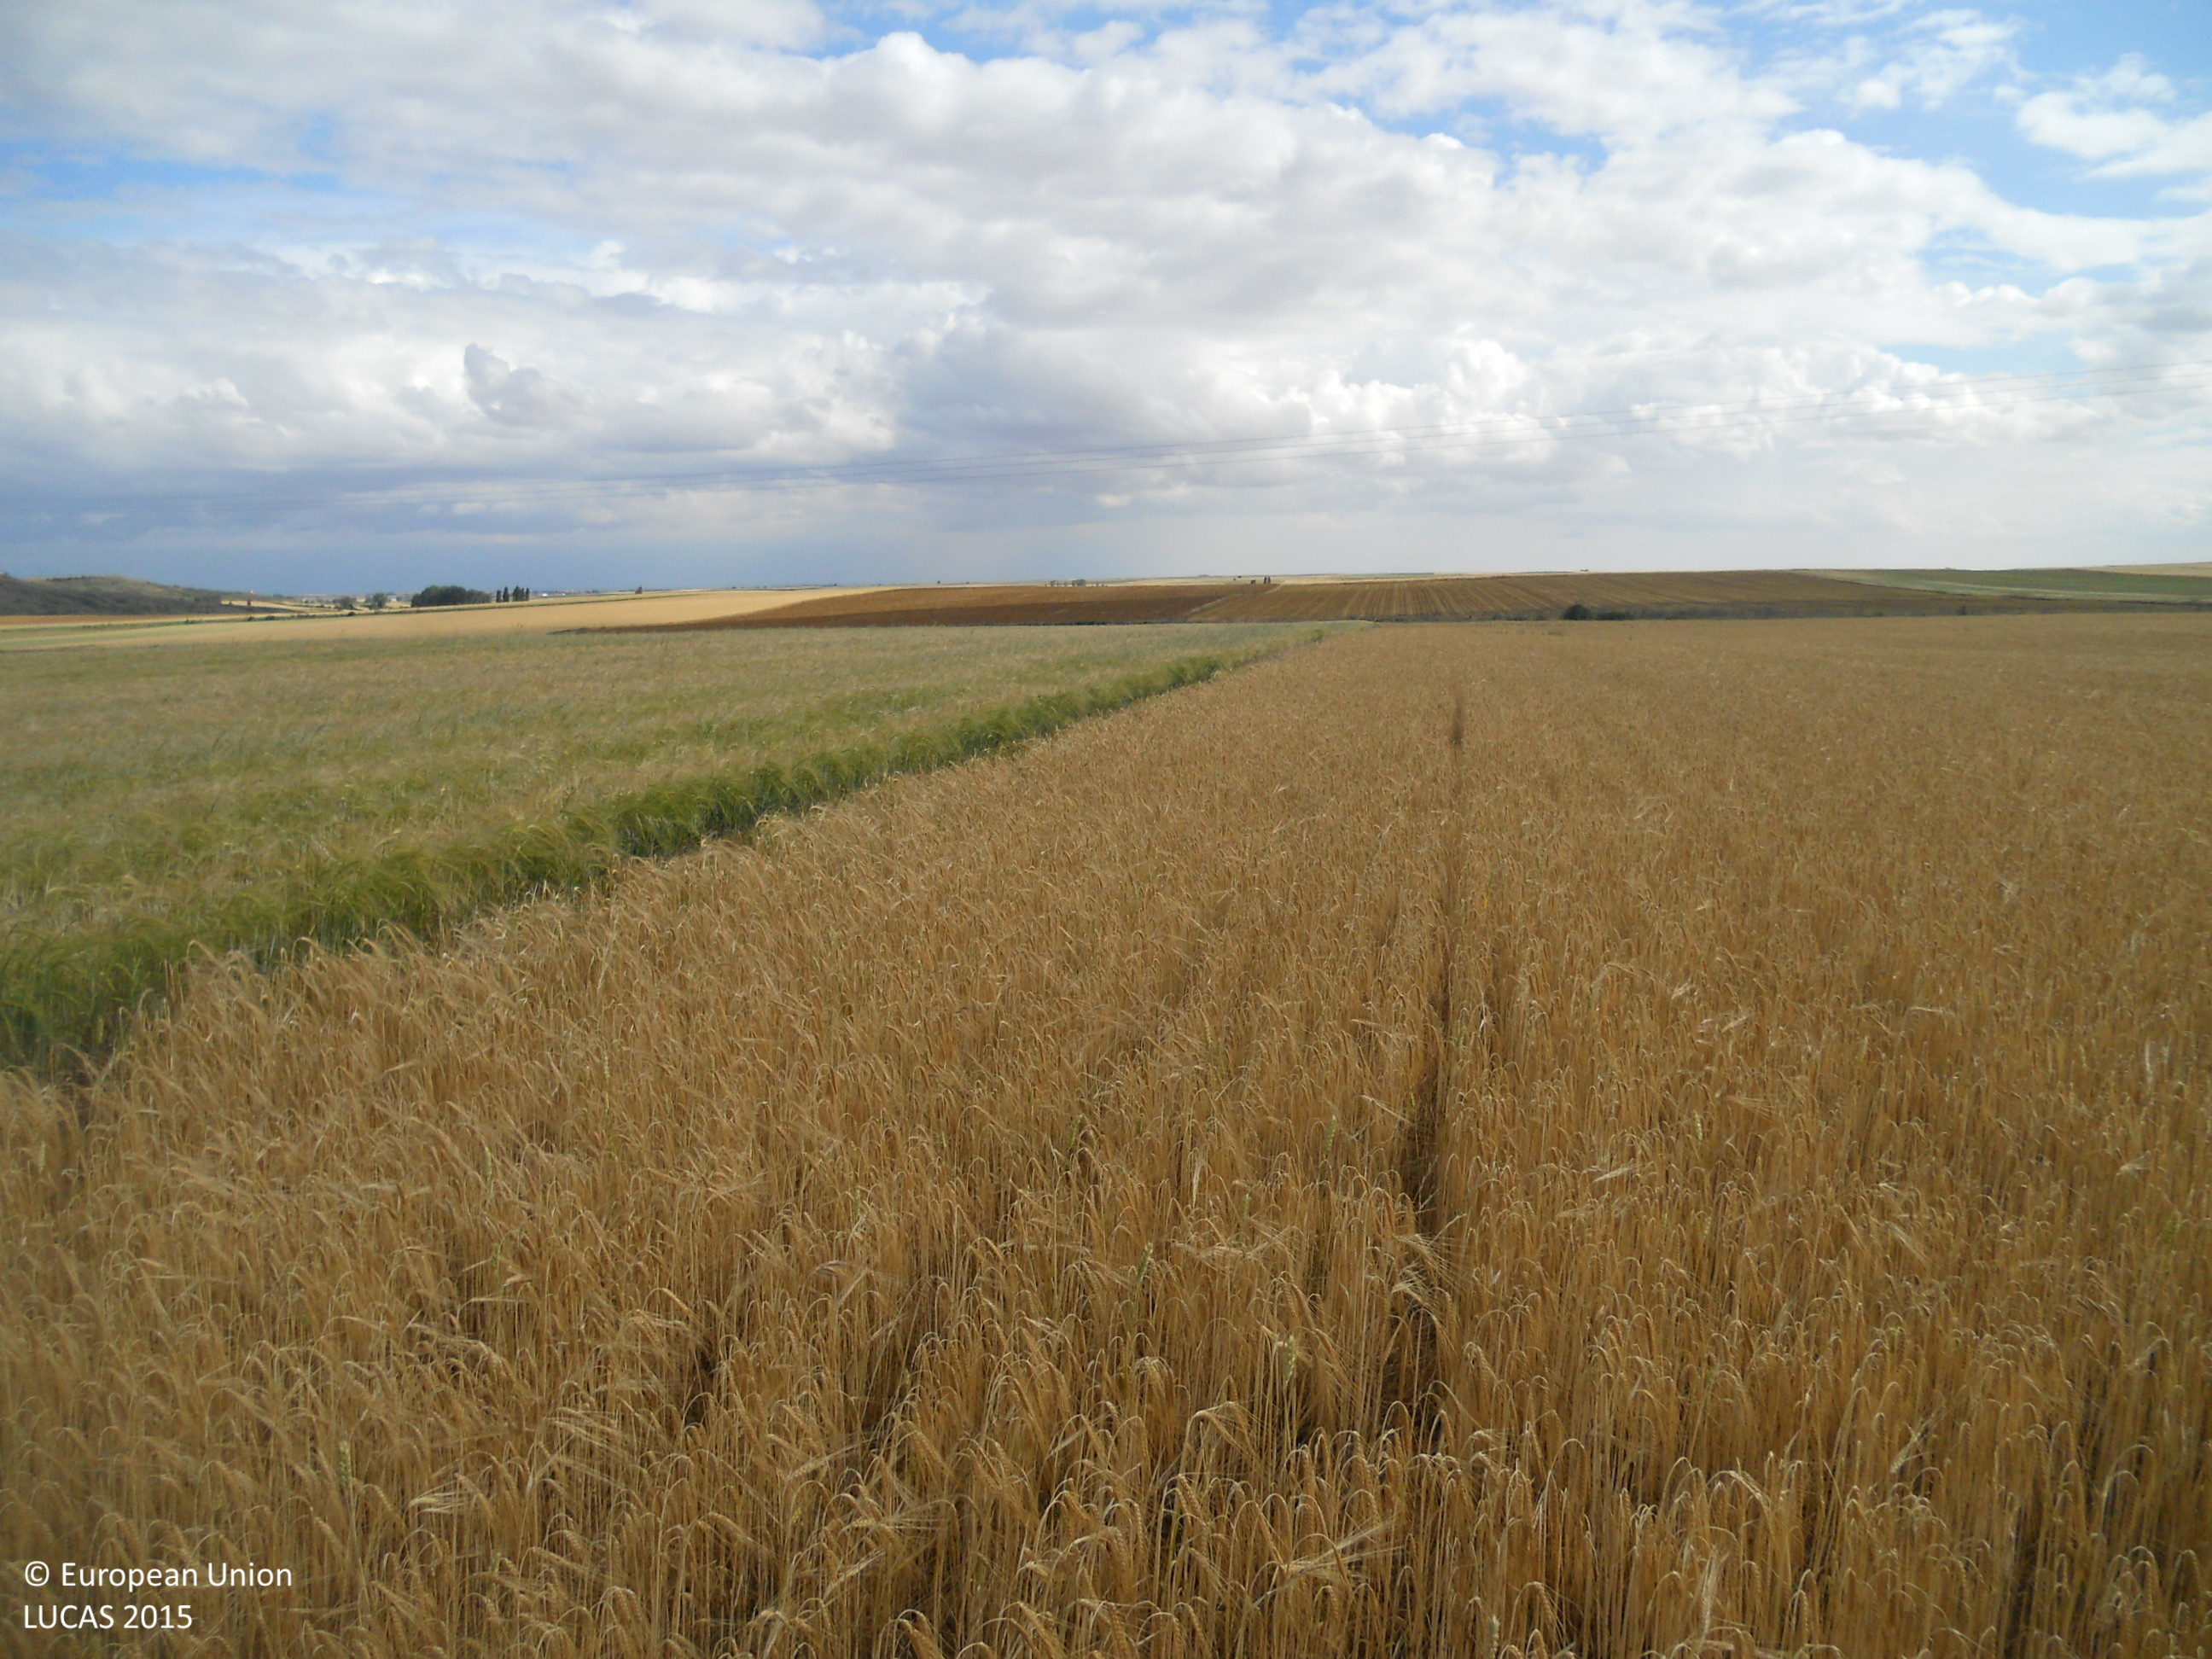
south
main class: Cropland
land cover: Barley
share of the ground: > 75 %
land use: Agriculture (excluding fallow land and kitchen gardens)
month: June
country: ES
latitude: 42.3545
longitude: -4.8797
